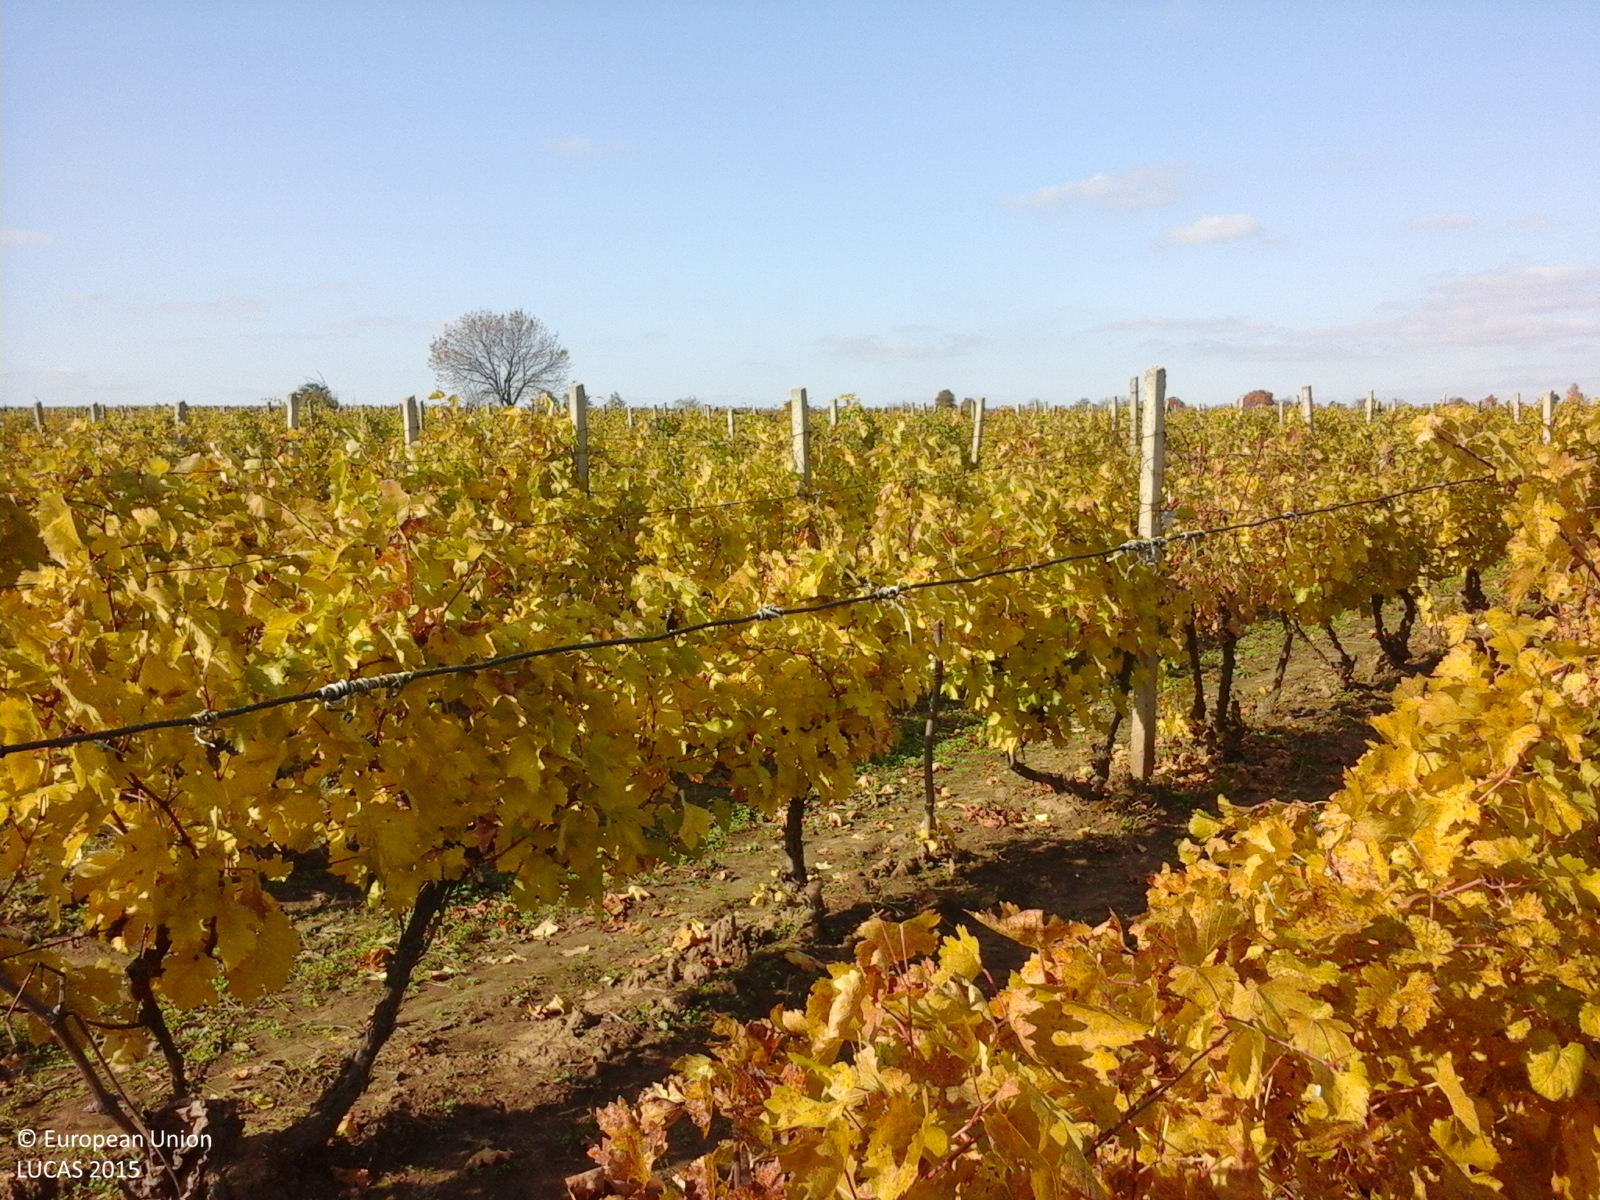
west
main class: Cropland
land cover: Vineyards
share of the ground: > 75 %
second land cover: Grassland without tree/shrub cover
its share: 25 - 50 %
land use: Agriculture (excluding fallow land and kitchen gardens)
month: October
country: RO
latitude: 45.9740
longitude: 27.0922
